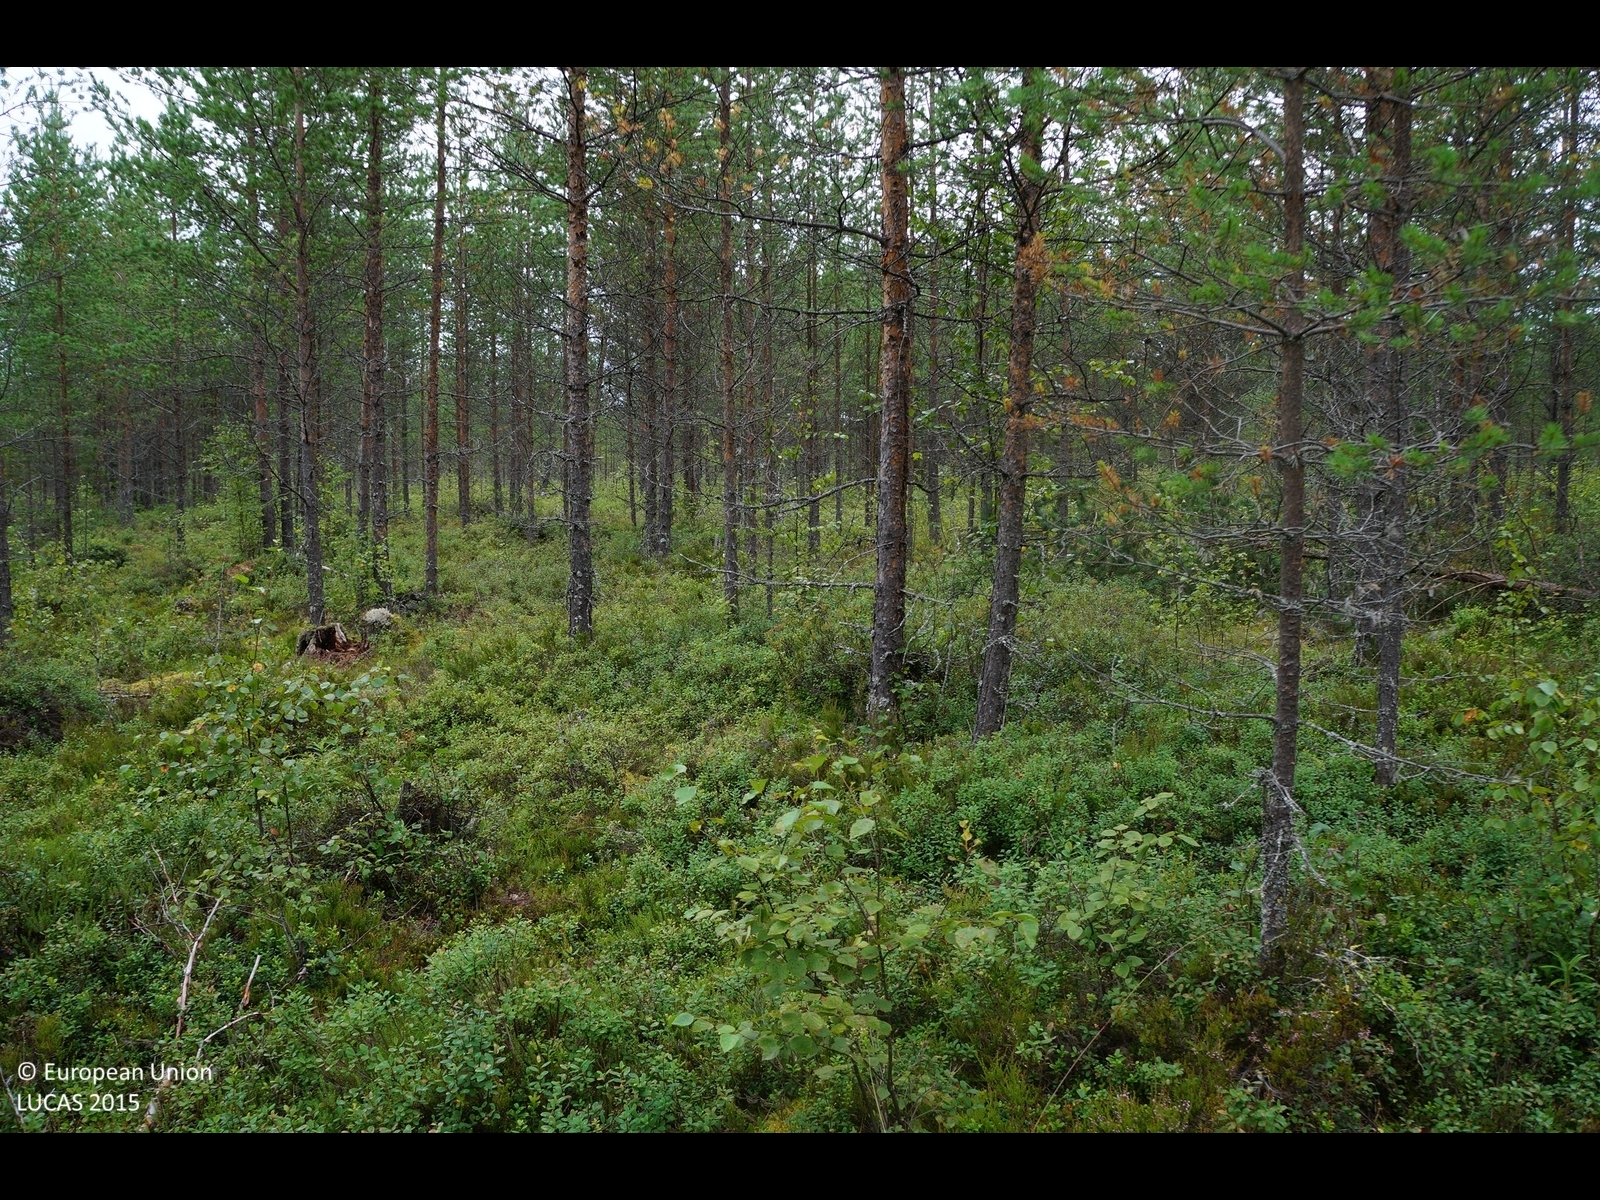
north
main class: Woodland
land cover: Pine dominated coniferous woodland
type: boreal forest
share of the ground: 25 - 50 %
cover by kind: shrubs 50 %, coniferous forest trees 35 %, lichens and mosses 10 %, broadleaved forest trees 5 %
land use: Forestry
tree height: > 5 m
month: August
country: FI
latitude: 64.2872
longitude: 25.9478
